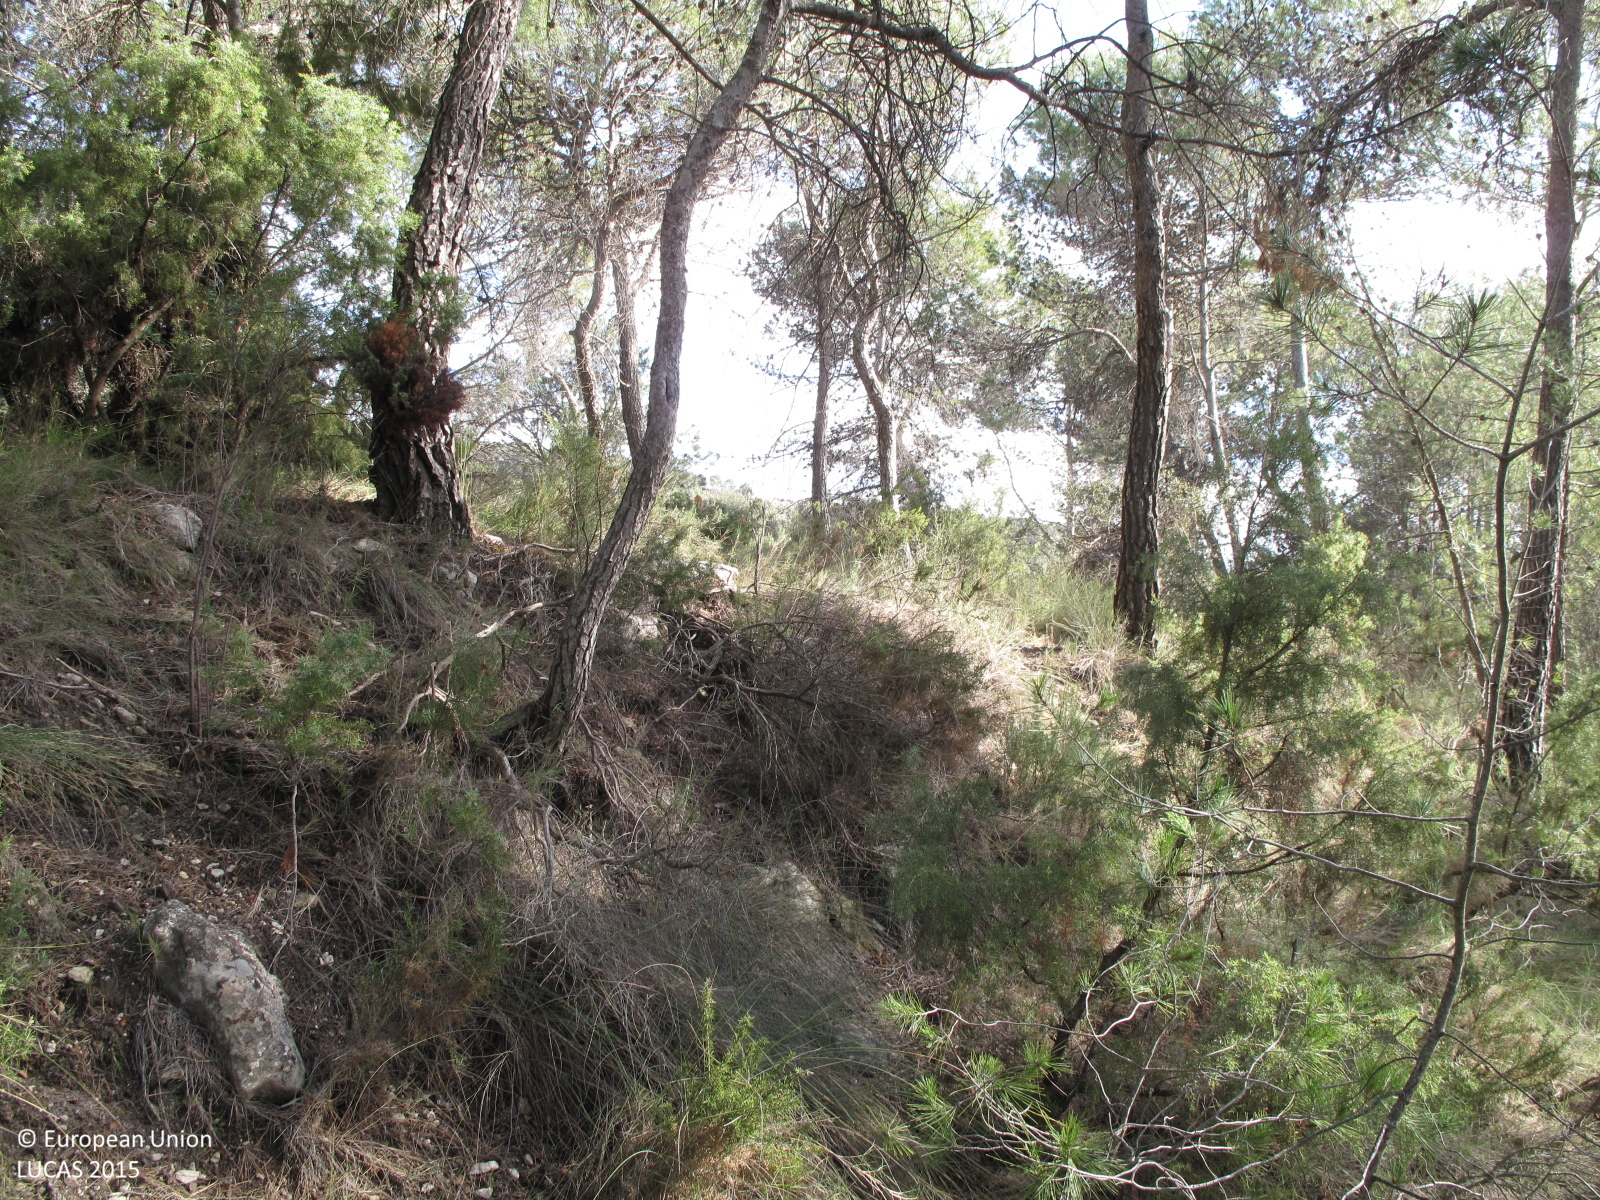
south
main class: Woodland
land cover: Pine dominated coniferous woodland
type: coniferous forest of the mediterranean region
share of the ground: > 75 %
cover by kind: coniferous forest trees 80 %, shrubs 10 %, herbaceous plants 10 %
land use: Semi-natural and natural areas not in use
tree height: > 5 m
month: March
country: ES
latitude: 38.7158
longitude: -0.5129
